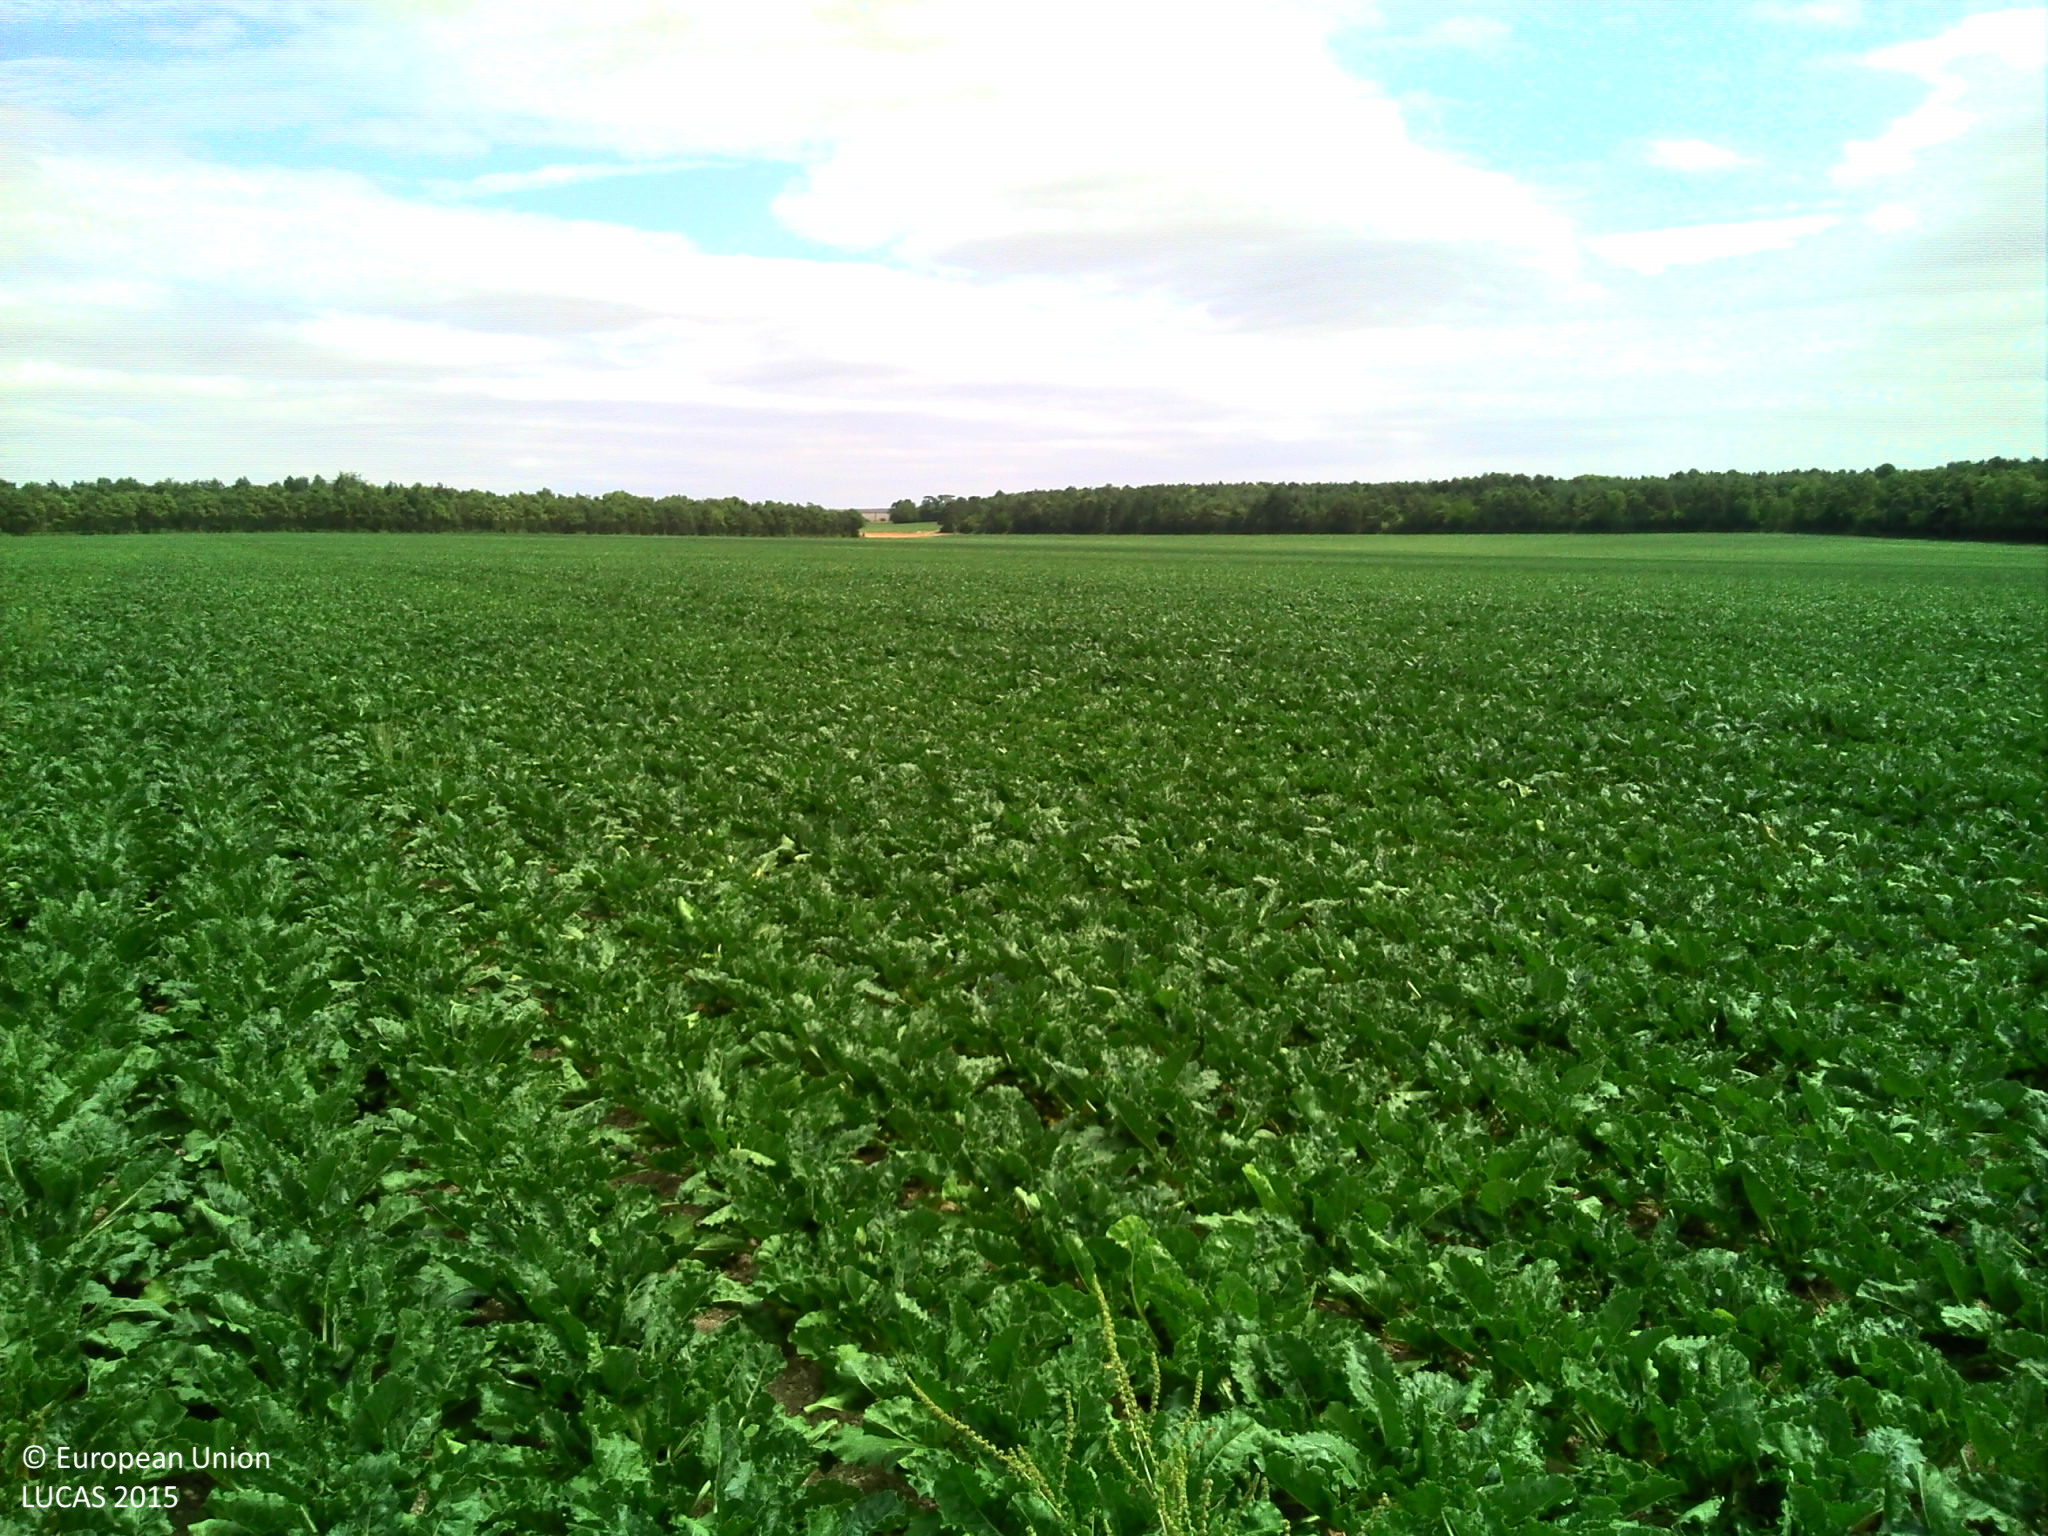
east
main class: Cropland
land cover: Sugar beet
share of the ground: > 75 %
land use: Agriculture (excluding fallow land and kitchen gardens)
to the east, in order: Sugar beet
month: July
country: FR
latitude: 49.4024
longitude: 4.1385
